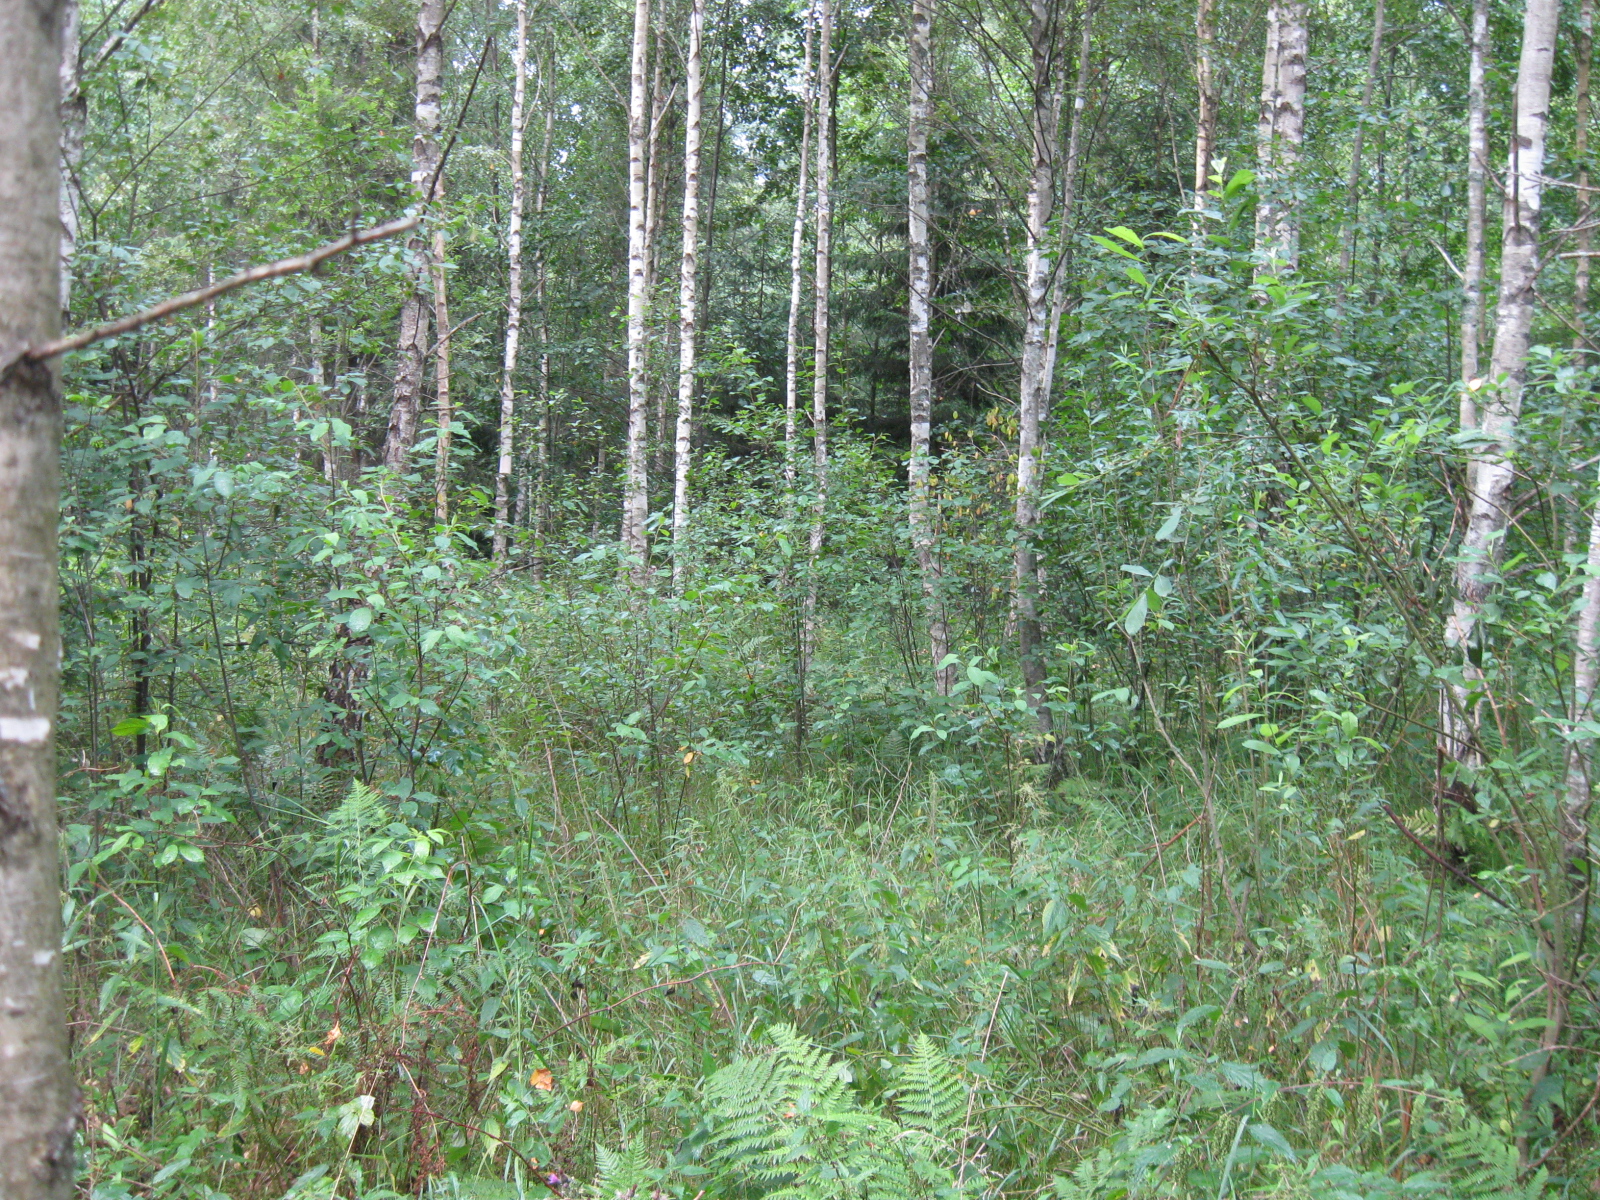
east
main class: Woodland
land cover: Broadleaved woodland
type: non-riverine alder, birch or aspen forest
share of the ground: > 75 %
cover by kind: broadleaved forest trees 70 %, herbaceous plants 20 %, coniferous forest trees 10 %
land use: Forestry
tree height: > 5 m
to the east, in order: Broadleaved woodland; Spruce dominated mixed woodland; Spruce dominated coniferous woodland; Spruce dominated mixed woodland; Tracks; Spruce dominated coniferous woodland; Tracks; Spruce dominated coniferous woodland; Pine dominated coniferous woodland; Tracks; Pine dominated coniferous woodland
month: July
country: LT
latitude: 54.9315
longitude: 23.5820
